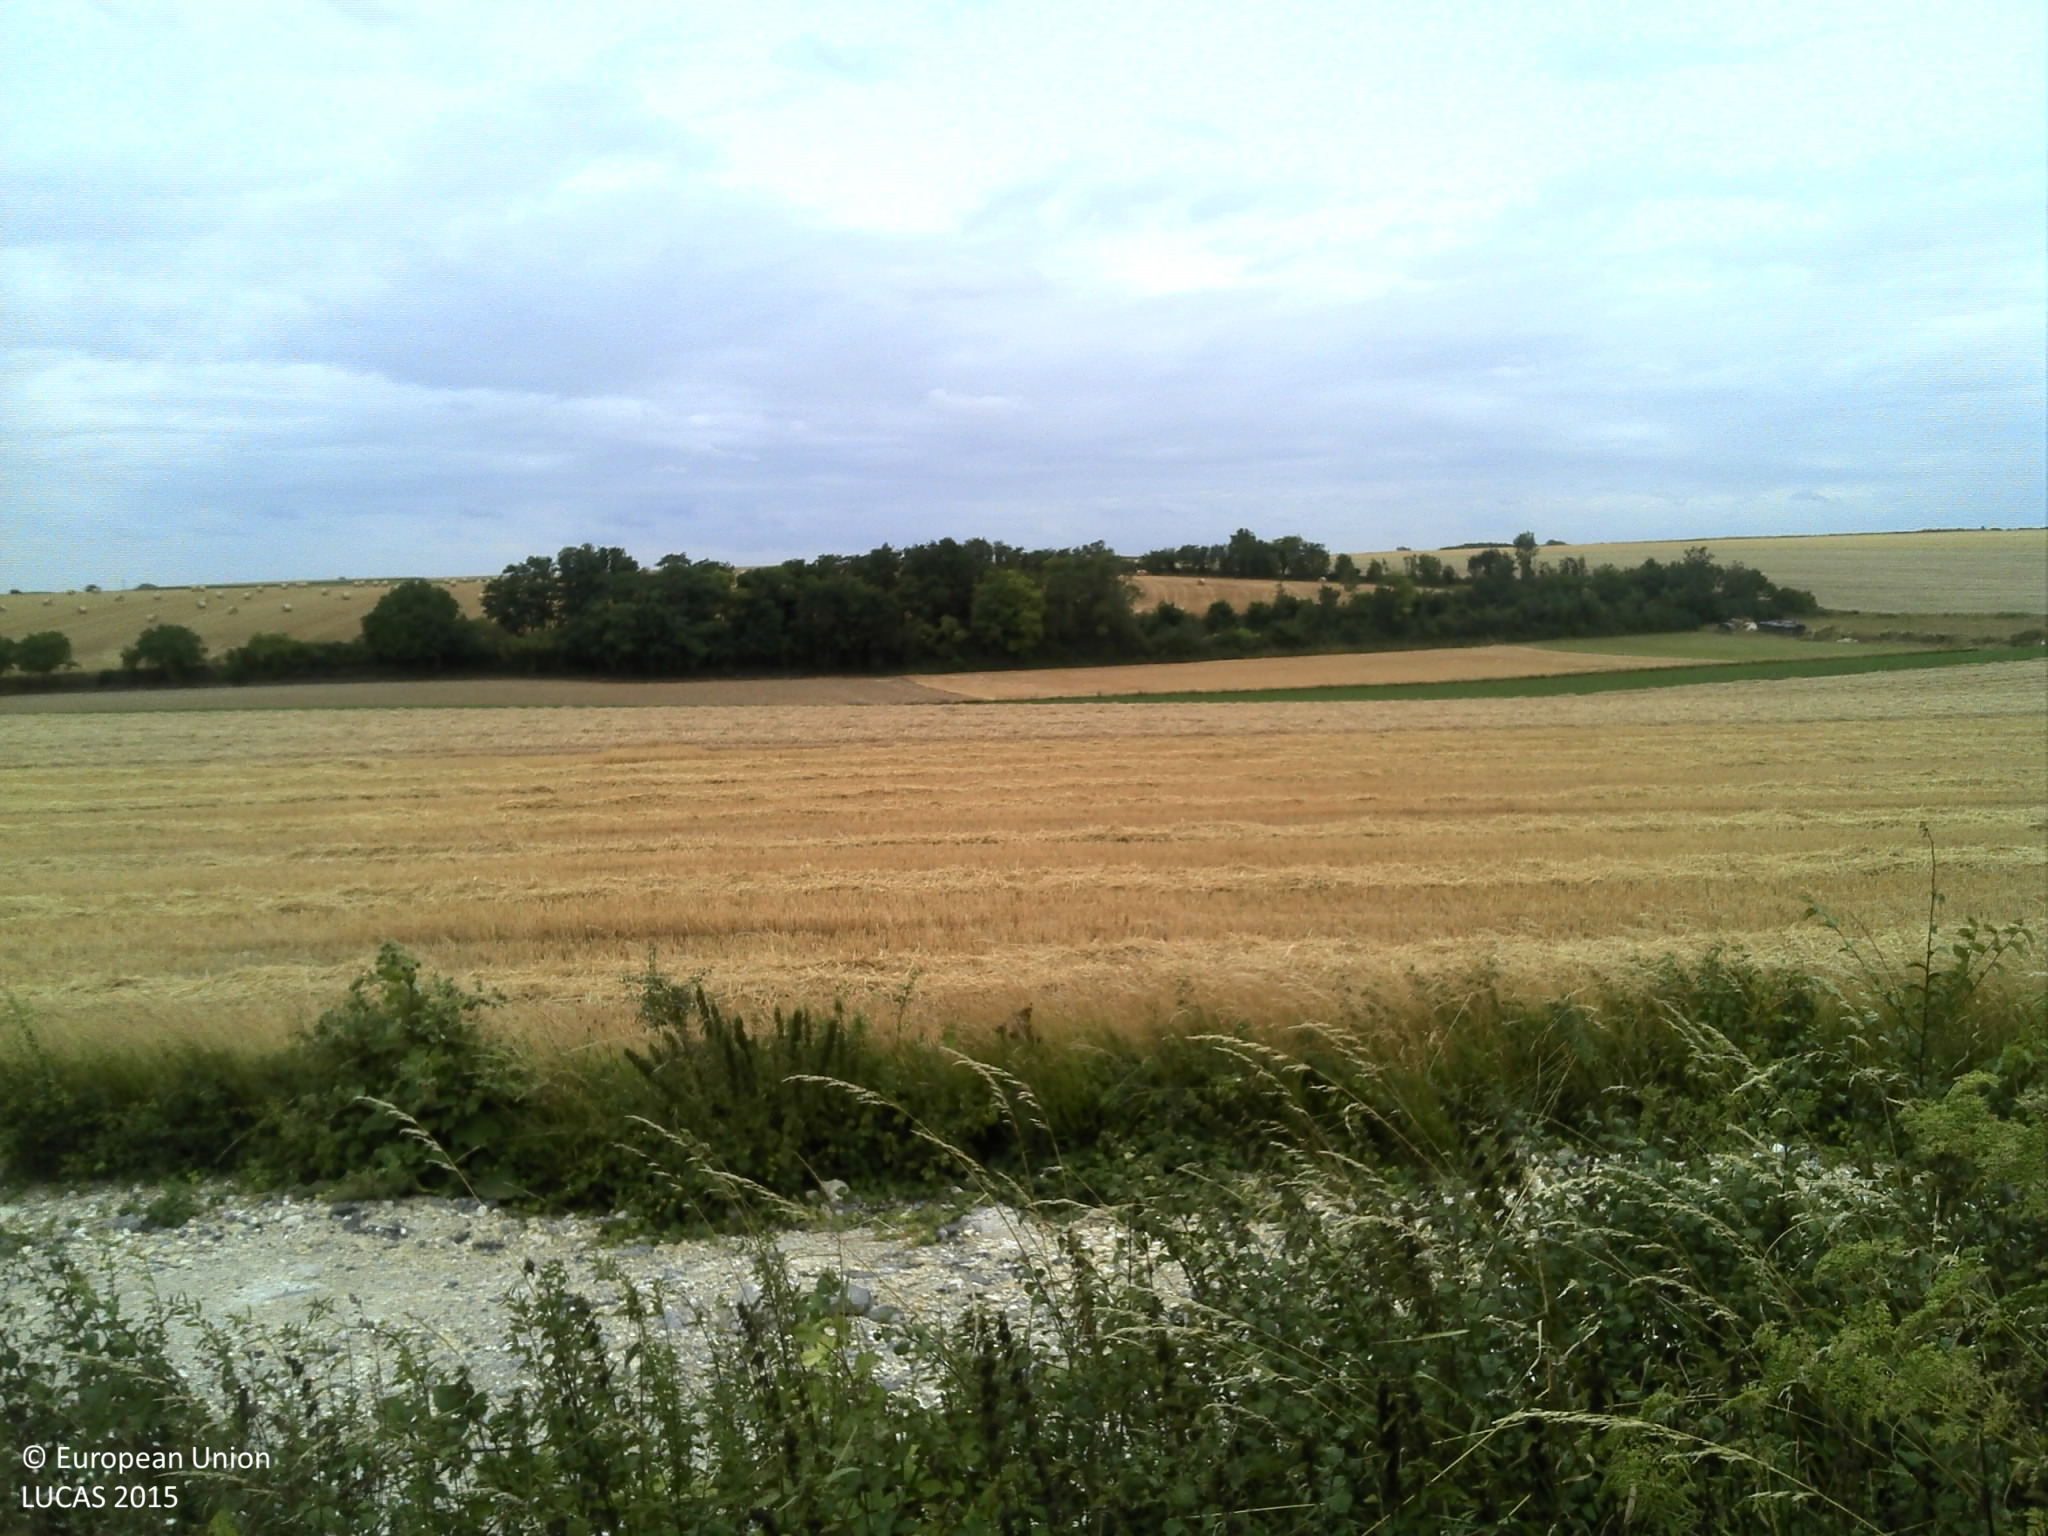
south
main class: Cropland
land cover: Maize
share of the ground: > 75 %
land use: Agriculture (excluding fallow land and kitchen gardens)
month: July
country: FR
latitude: 49.5085
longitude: 4.0980
